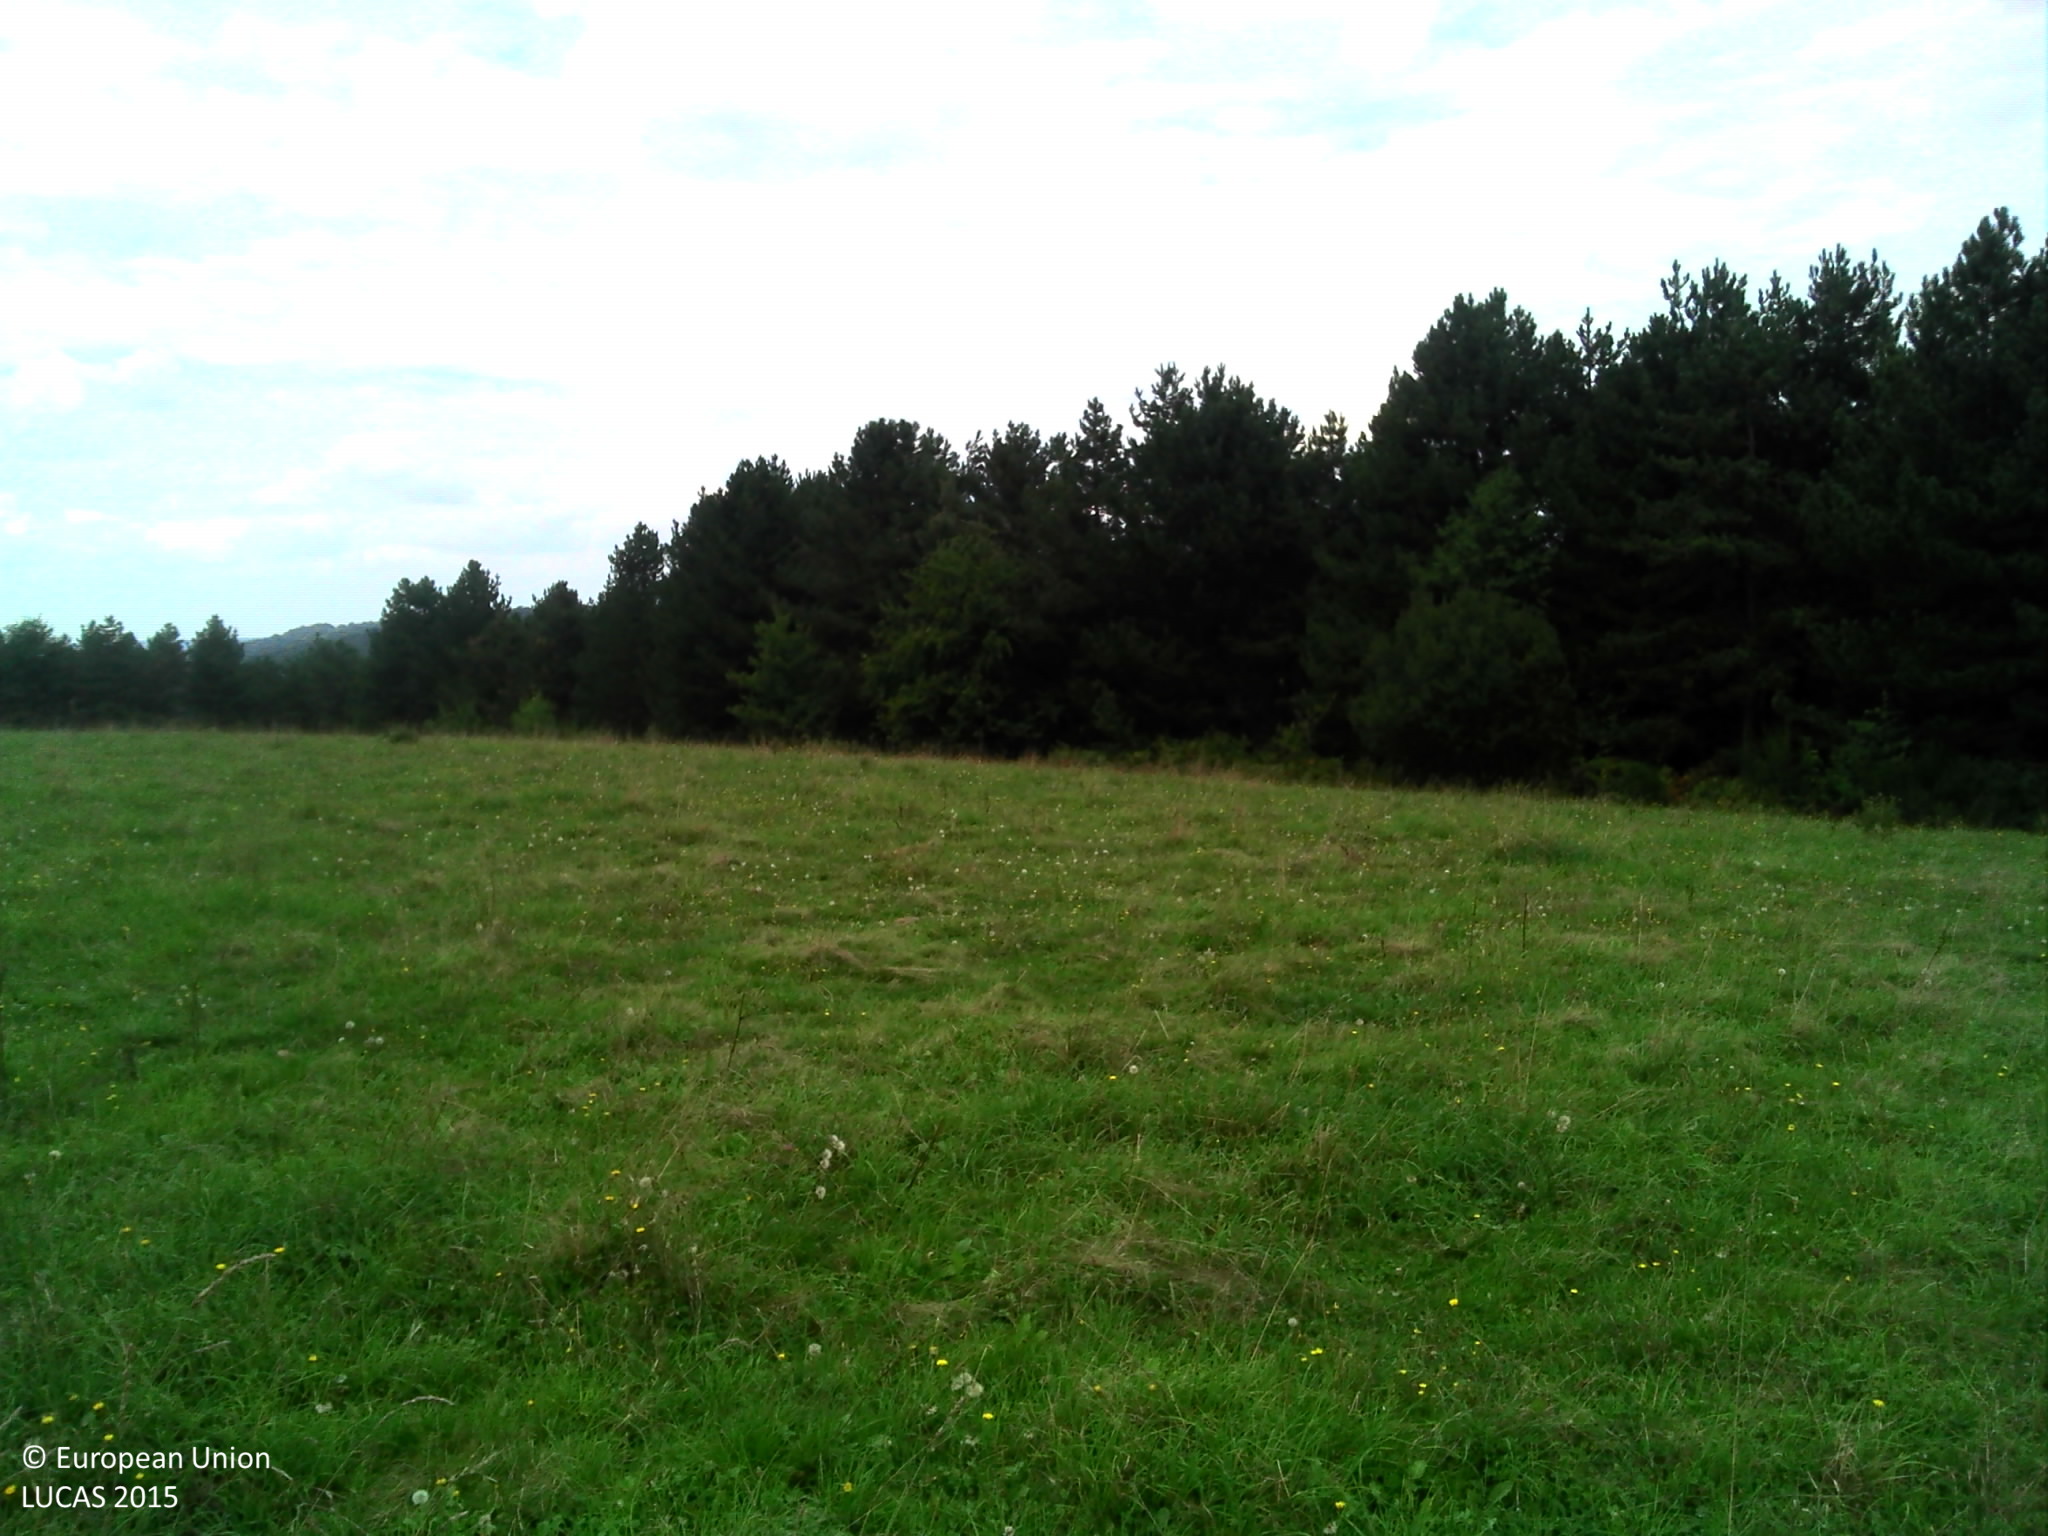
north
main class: Grassland
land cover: Grassland without tree/shrub cover
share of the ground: > 75 %
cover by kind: herbaceous plants 100 %
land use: Agriculture (excluding fallow land and kitchen gardens)
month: September
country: FR
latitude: 43.4136
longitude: -0.1700
